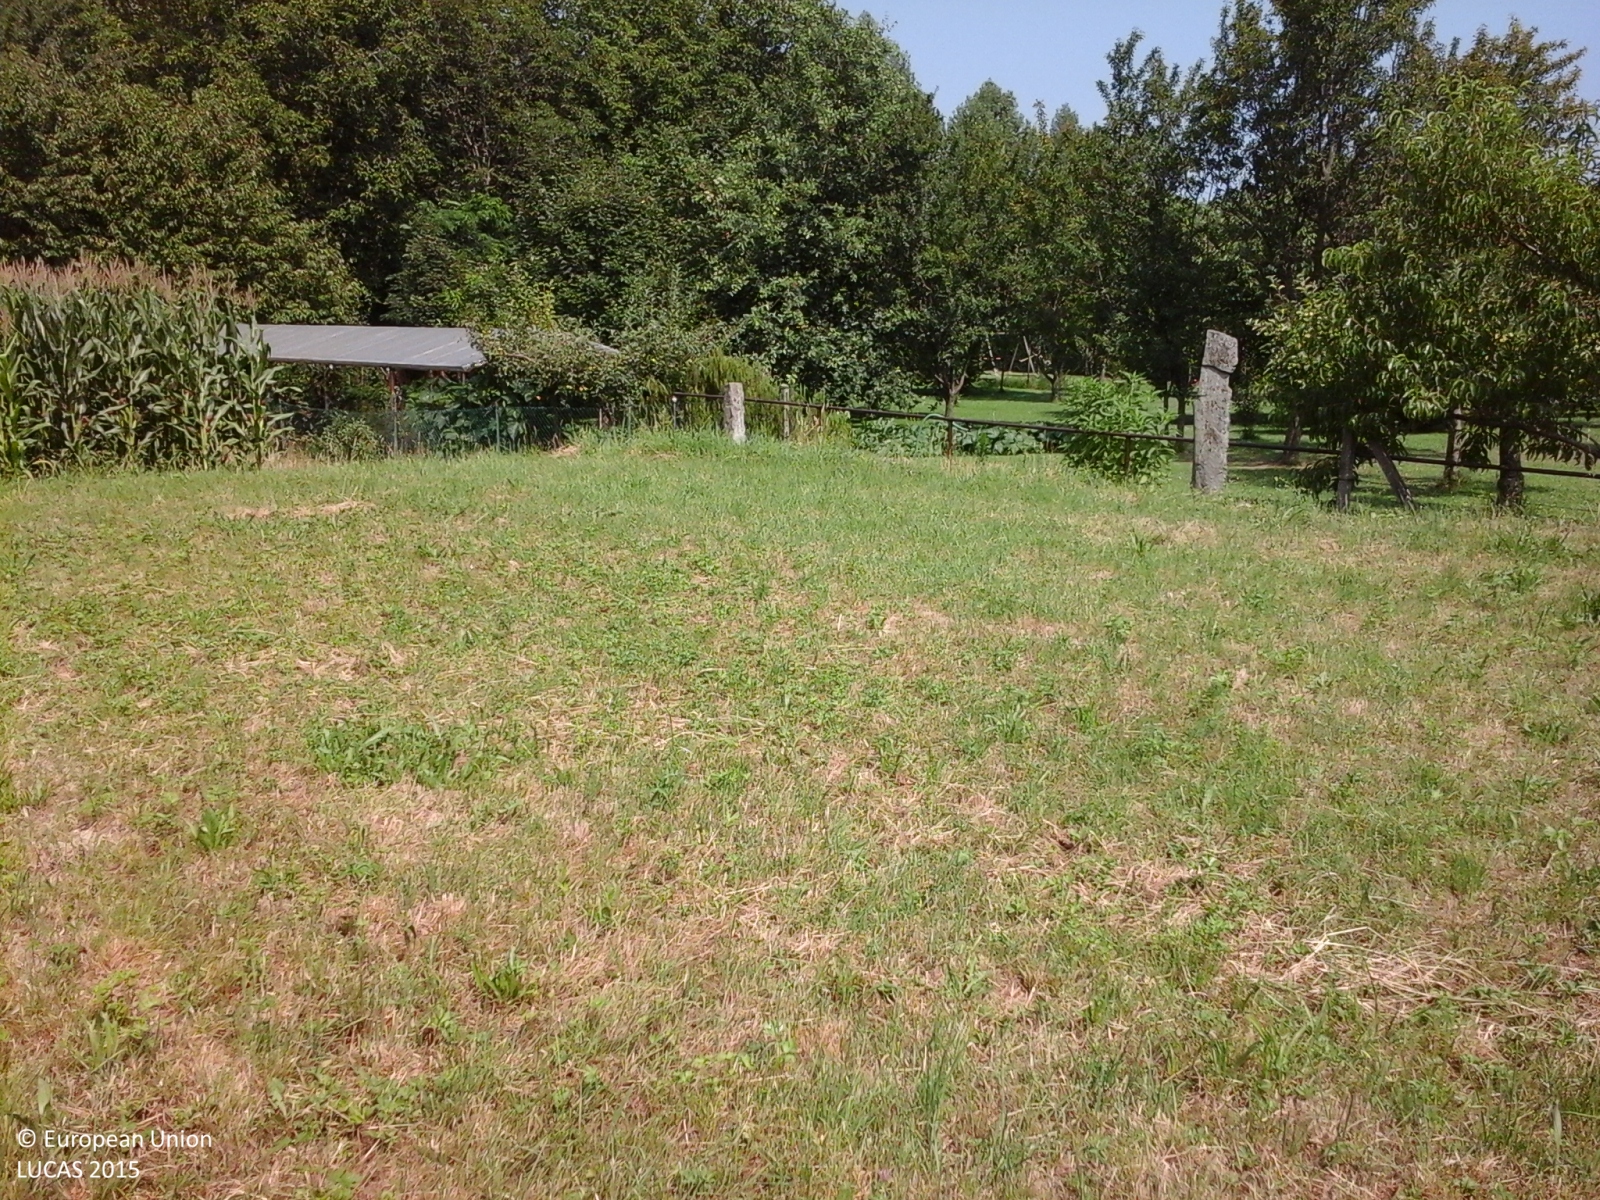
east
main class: Grassland
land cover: Grassland without tree/shrub cover
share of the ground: > 75 %
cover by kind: herbaceous plants 100 %
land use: Agriculture (excluding fallow land and kitchen gardens)
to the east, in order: Grassland without tree/shrub cover; Ditches and canals; Artificial constructions in urban areas; Grassland with sparse tree/shrub cover; Broadleaved woodland; Fences; Grassland without tree/shrub cover; Fences; Broadleaved woodland; Inland fresh running water; Paved roads, cycling and walking lanes; Inland fresh running water; Artificial constructions in urban areas
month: July
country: IT
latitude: 44.8750
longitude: 7.3086
